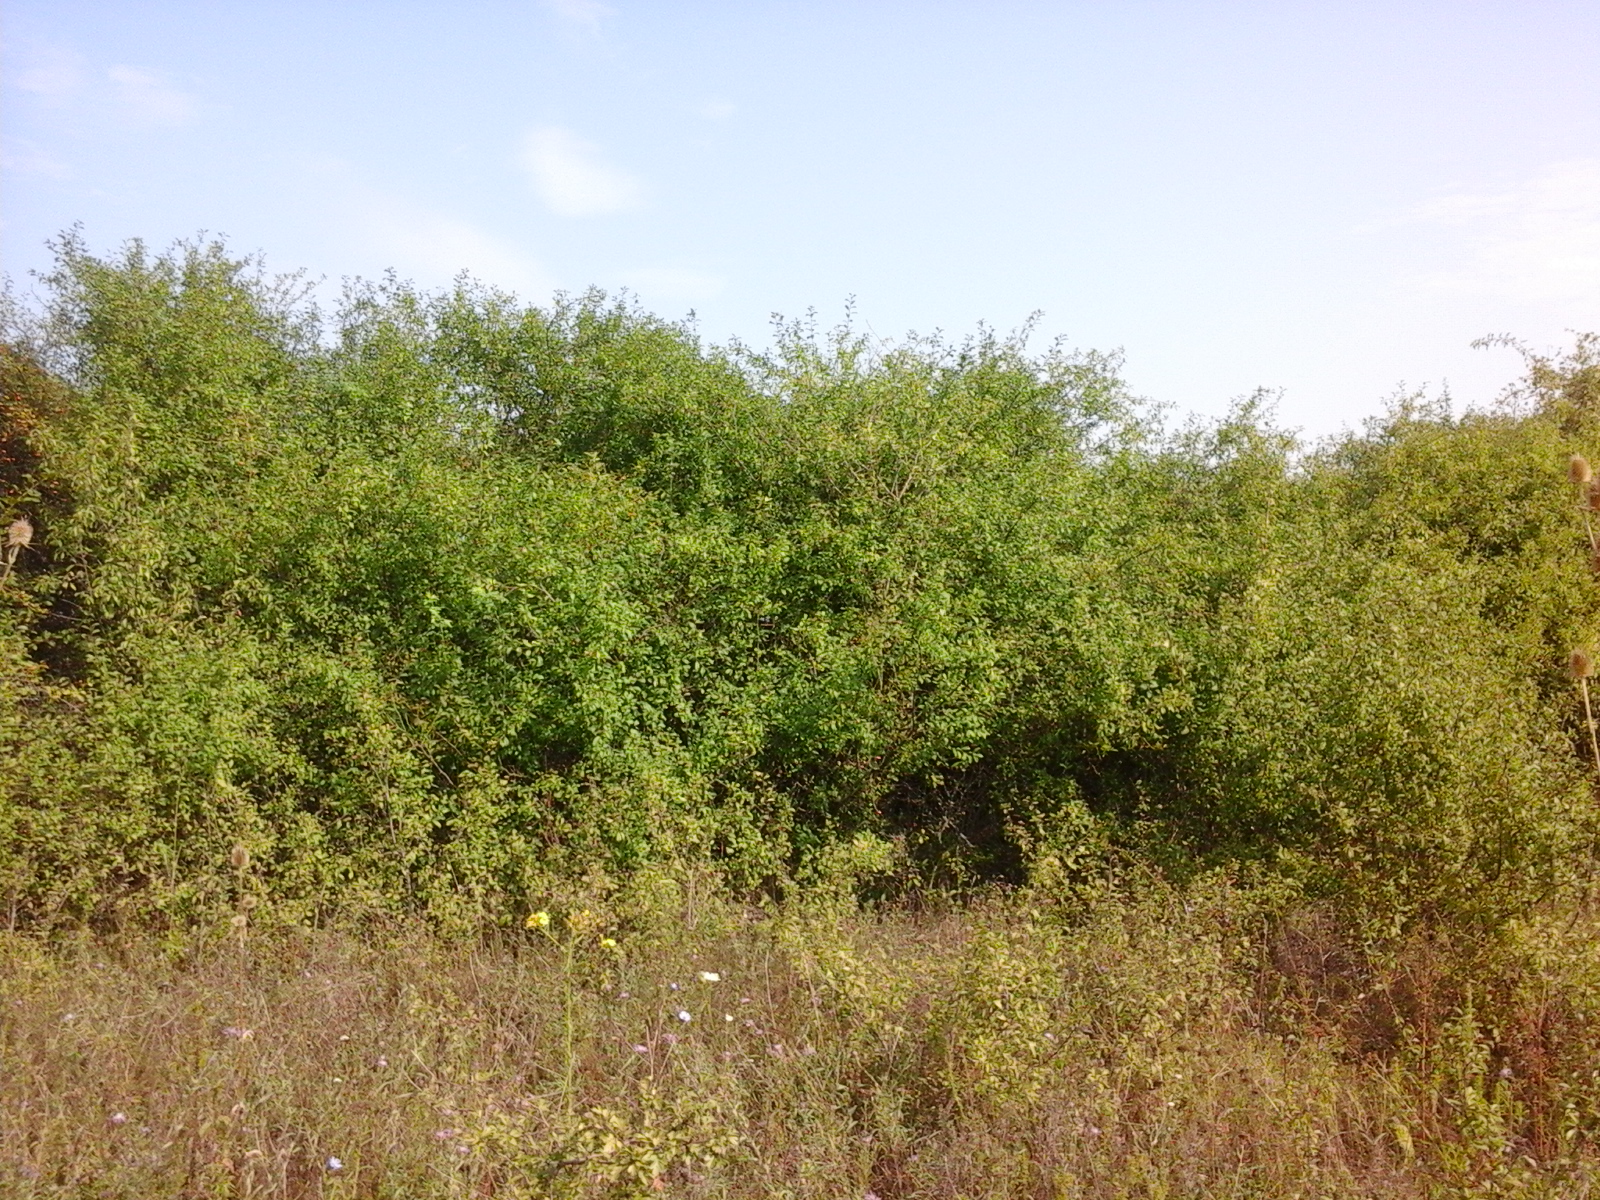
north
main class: Grassland
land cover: Spontaneously vegetated surfaces
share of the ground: > 75 %
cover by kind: herbaceous plants 100 %
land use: Agriculture (excluding fallow land and kitchen gardens)
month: August
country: RO
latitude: 46.6046
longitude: 21.8051
